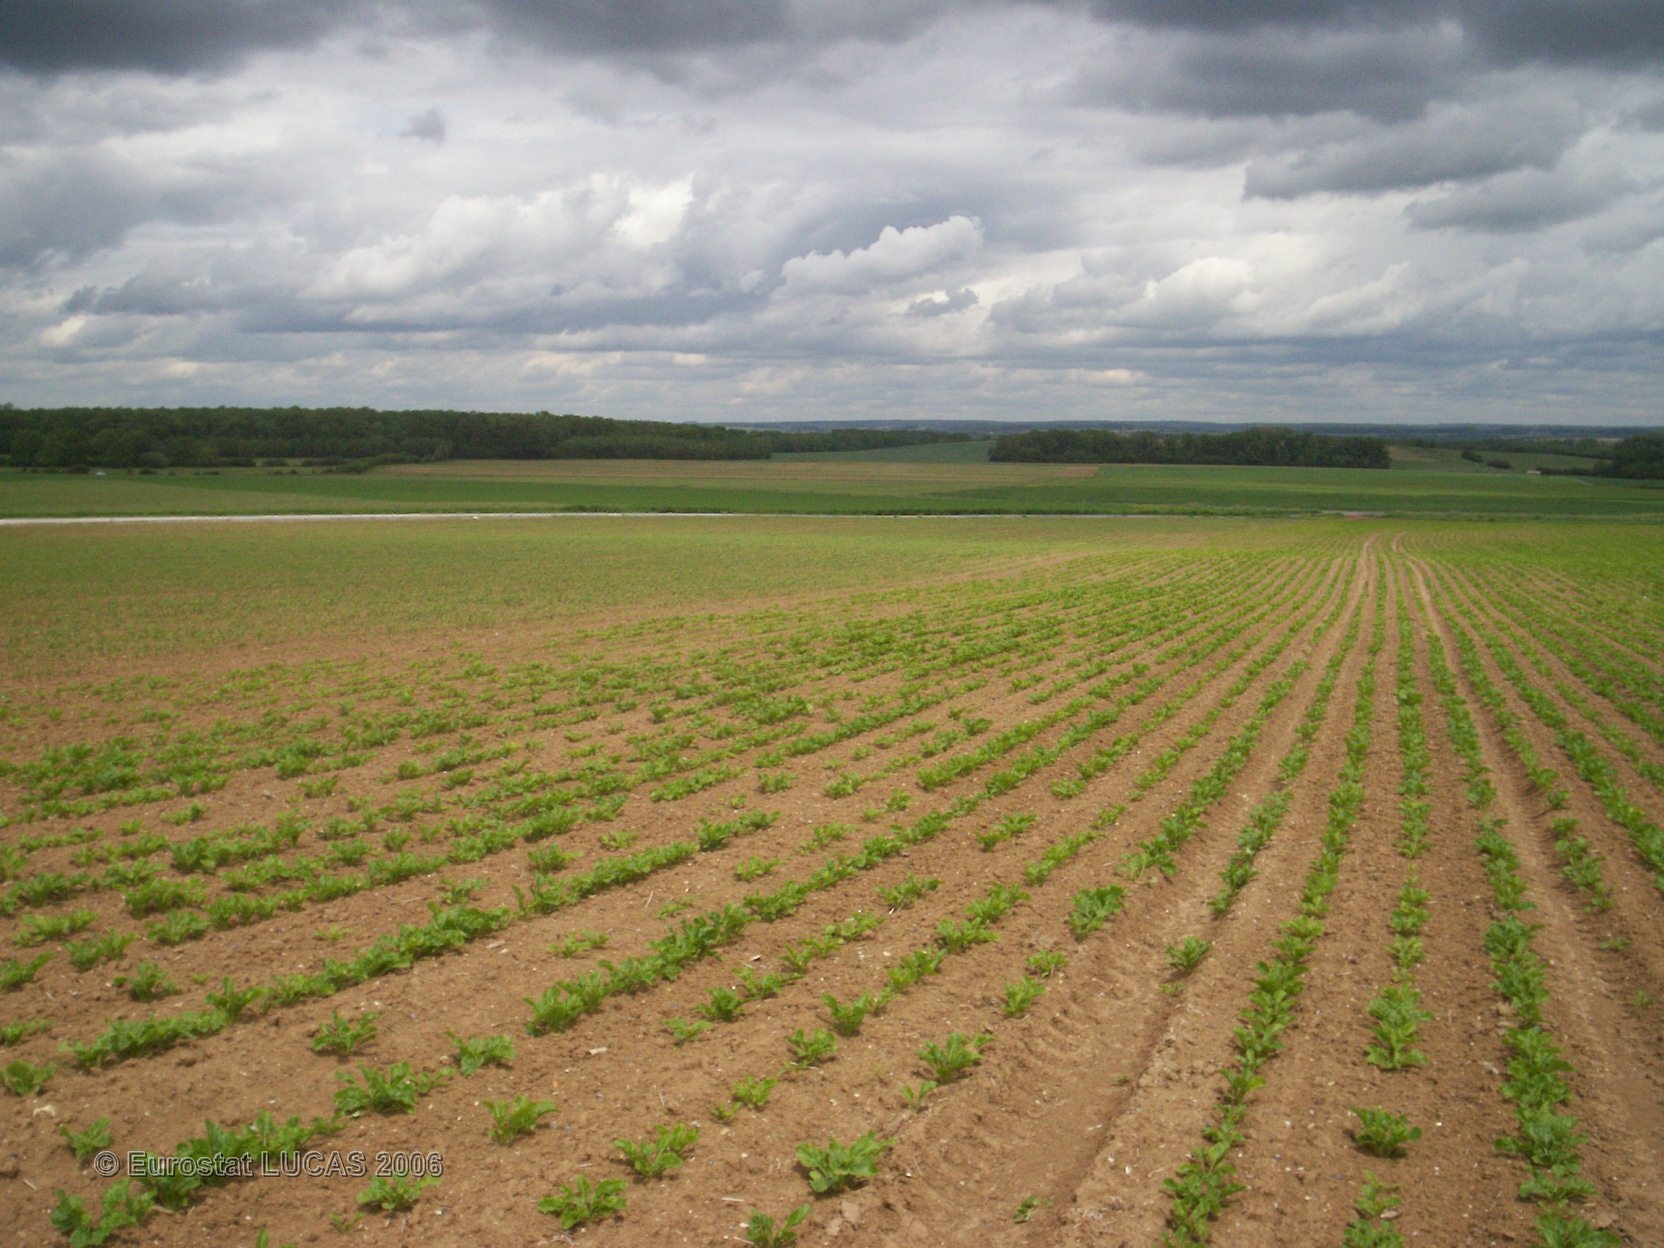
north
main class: Cropland
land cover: Sugar beet
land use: Agriculture (excluding fallow land and kitchen gardens)
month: May
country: FR
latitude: 49.5418
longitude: 4.3989
